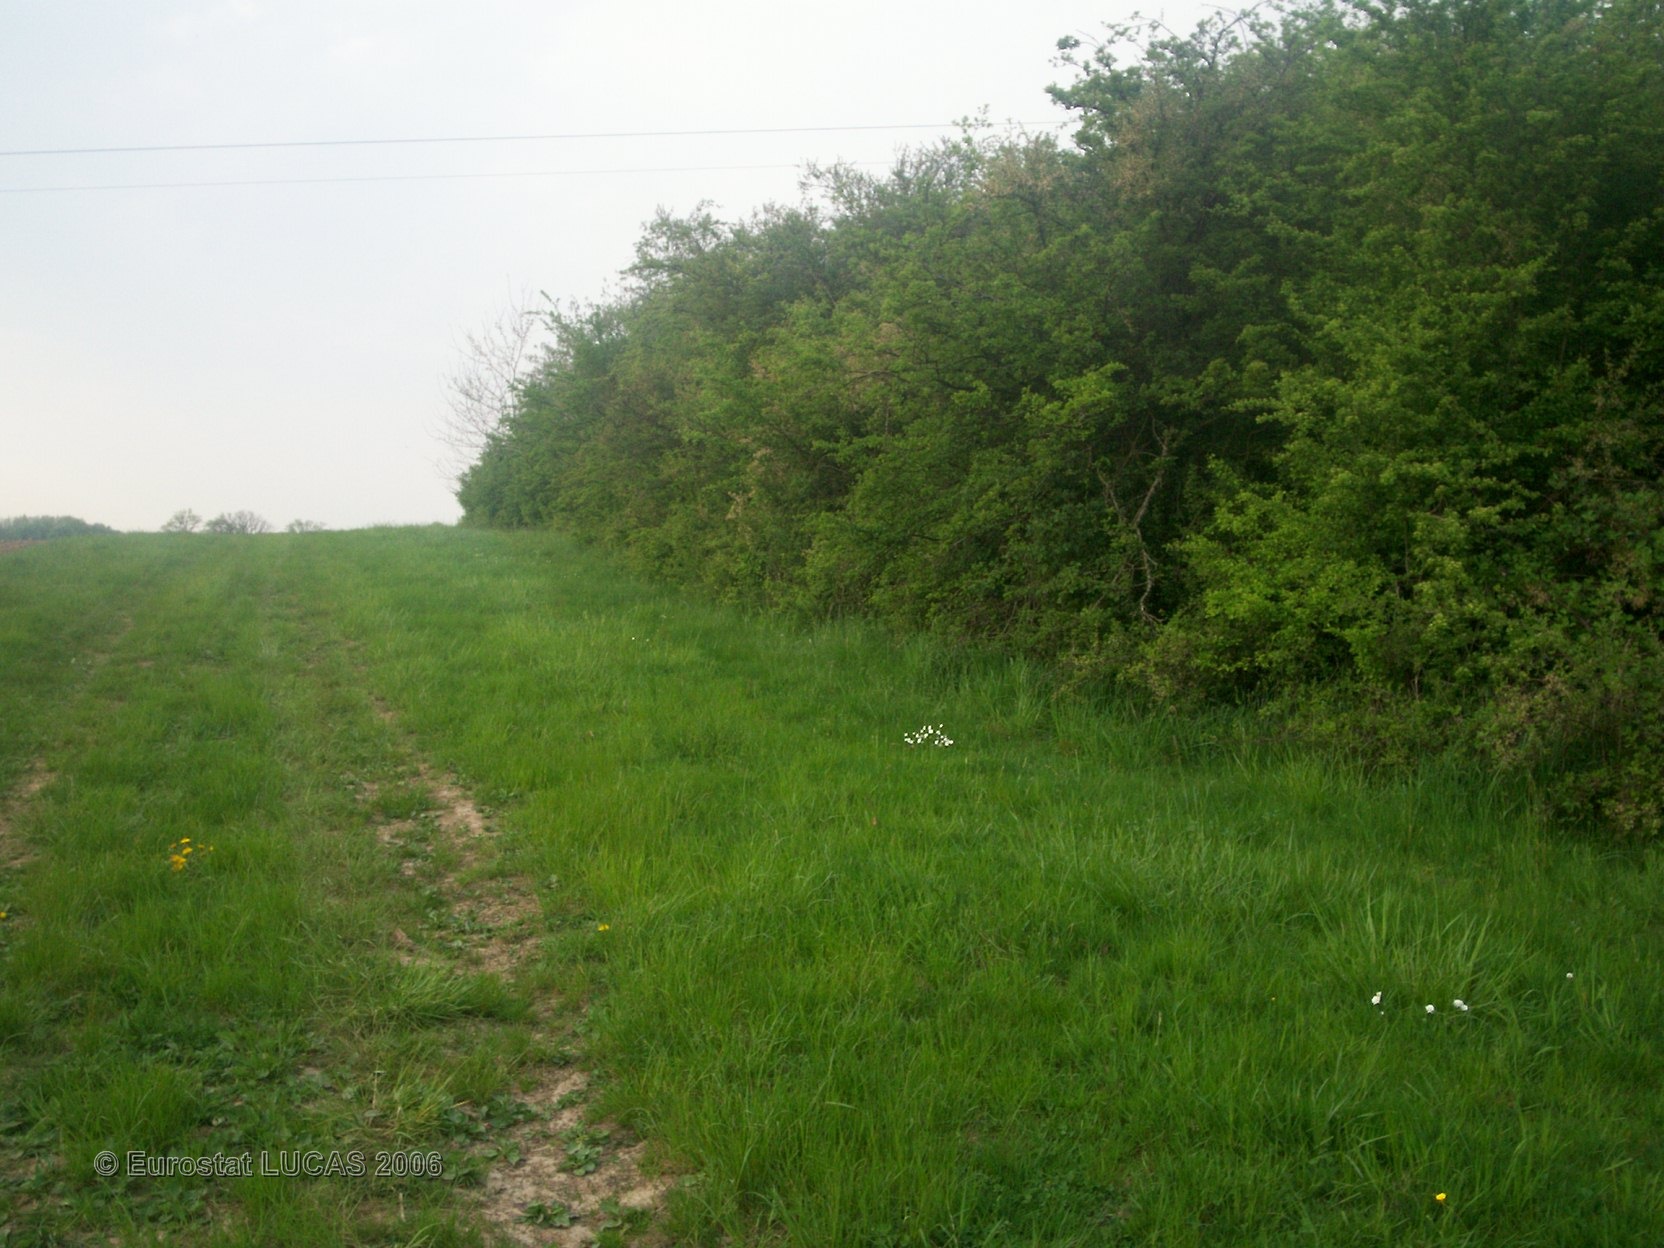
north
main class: Artificial land
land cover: Non built-up linear features
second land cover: Grassland without tree/shrub cover
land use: Road transport
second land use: Agriculture (excluding fallow land and kitchen gardens)
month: May
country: FR
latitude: 48.8127
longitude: 6.9910
